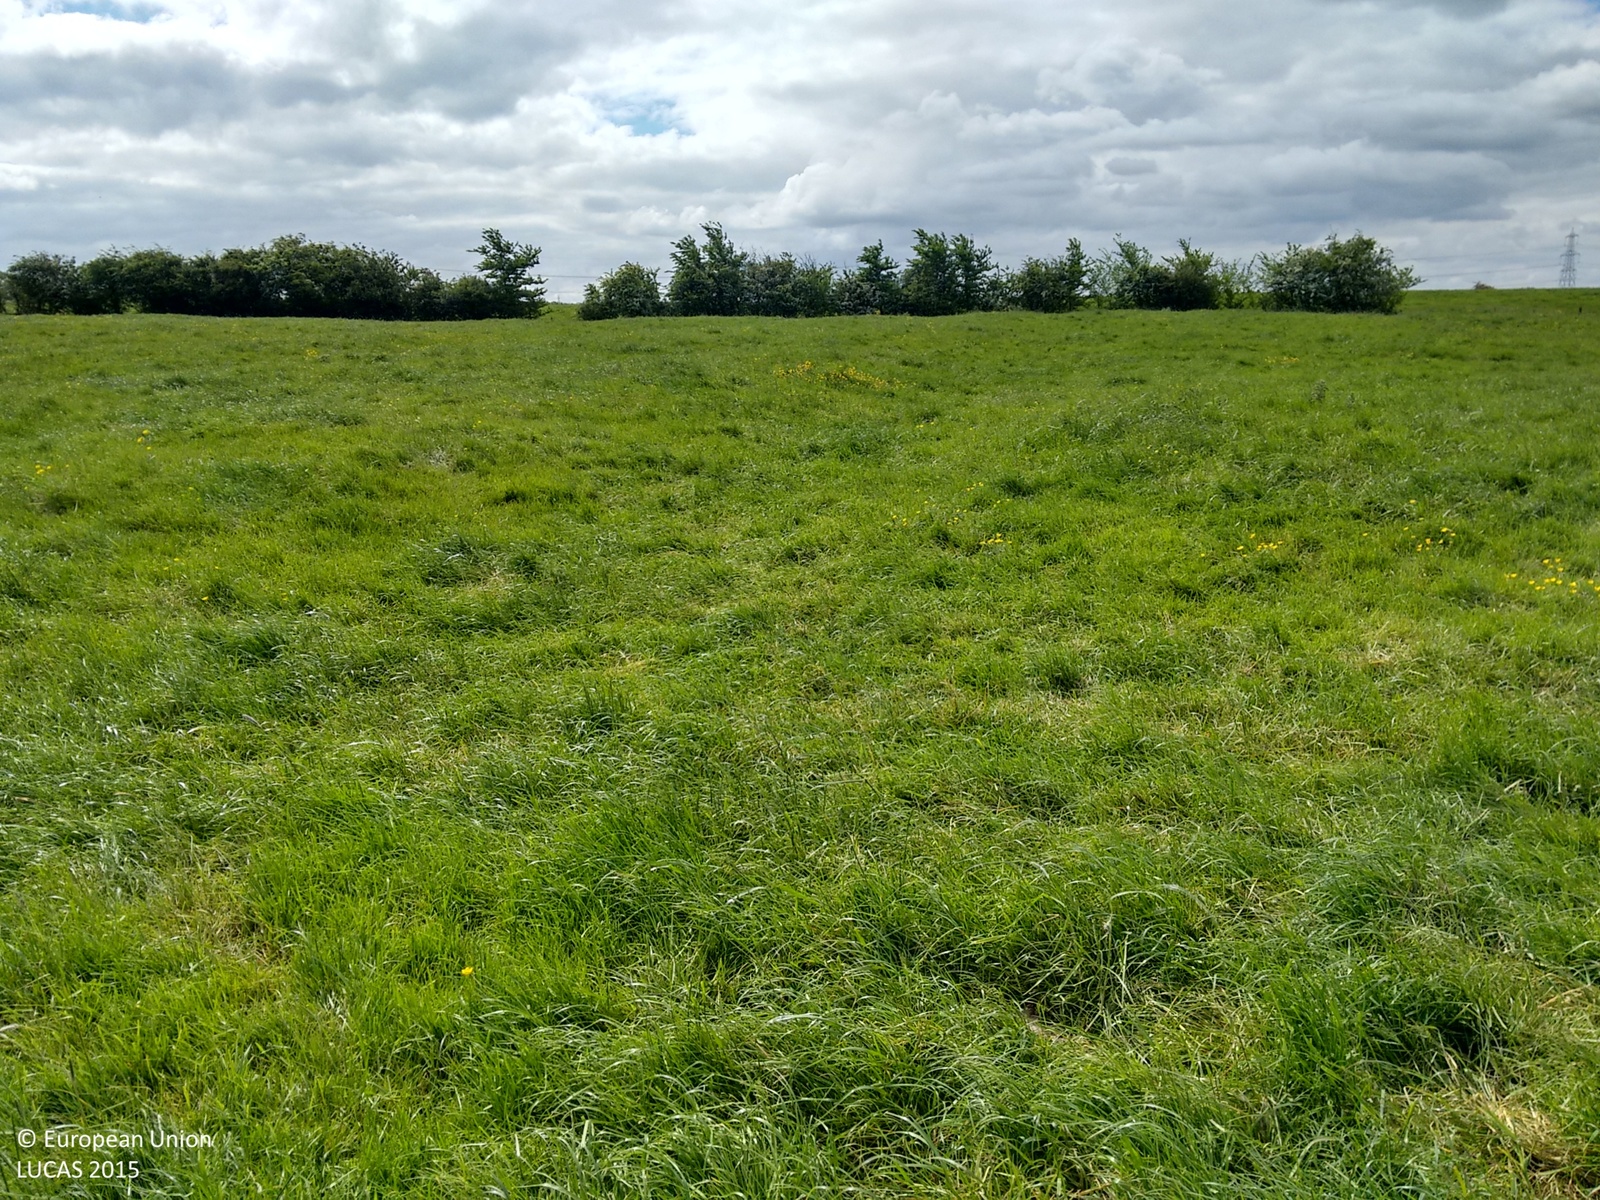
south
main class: Grassland
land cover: Grassland without tree/shrub cover
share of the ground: > 75 %
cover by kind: herbaceous plants 100 %
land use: Agriculture (excluding fallow land and kitchen gardens)
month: June
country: GB
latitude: 52.5182
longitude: -1.3819
